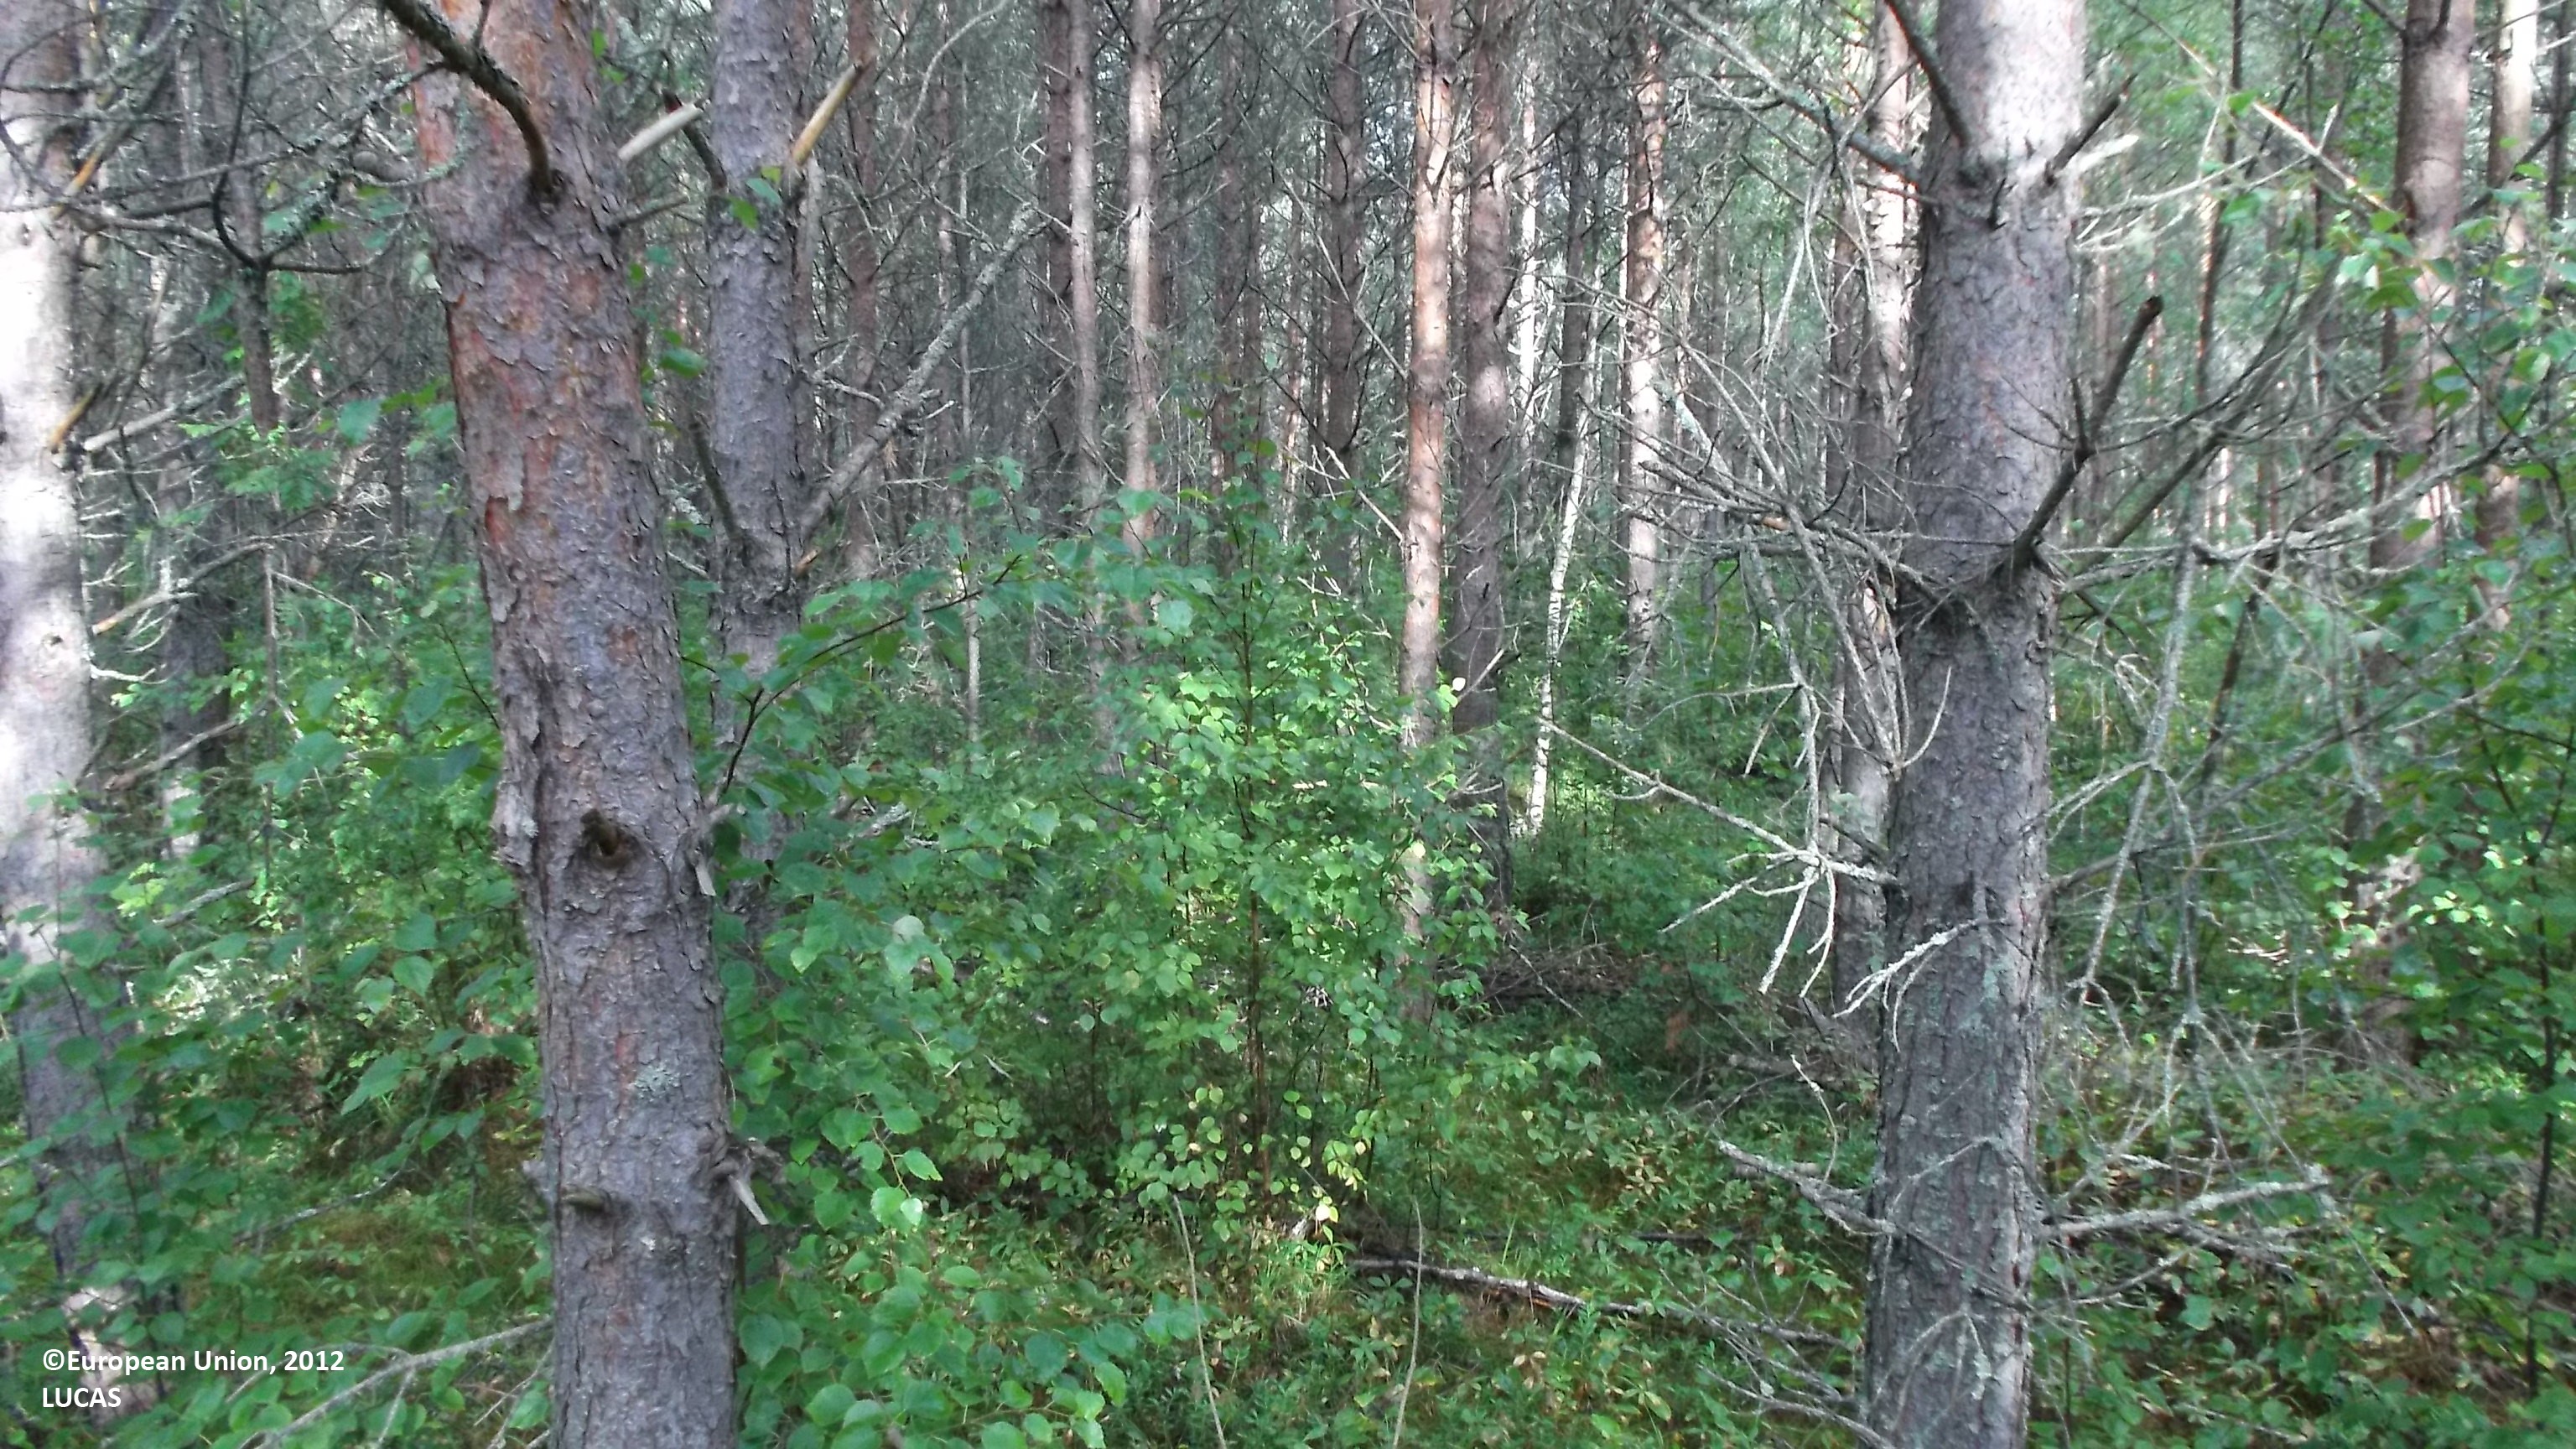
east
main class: Woodland
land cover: Pine dominated coniferous woodland
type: boreal forest
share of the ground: 50 - 75 %
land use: Forestry
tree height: > 5 m
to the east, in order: Pine dominated coniferous woodland; Pine dominated mixed woodland; Pine dominated coniferous woodland; Other mixed woodland; Grassland with sparse tree/shrub cover; Ditches and canals; Grassland with sparse tree/shrub cover; Other mixed woodland; Broadleaved woodland; Ditches and canals; Other mixed woodland; Spruce dominated coniferous woodland; Spruce dominated mixed woodland
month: August
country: FI
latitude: 63.9320
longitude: 23.4574
